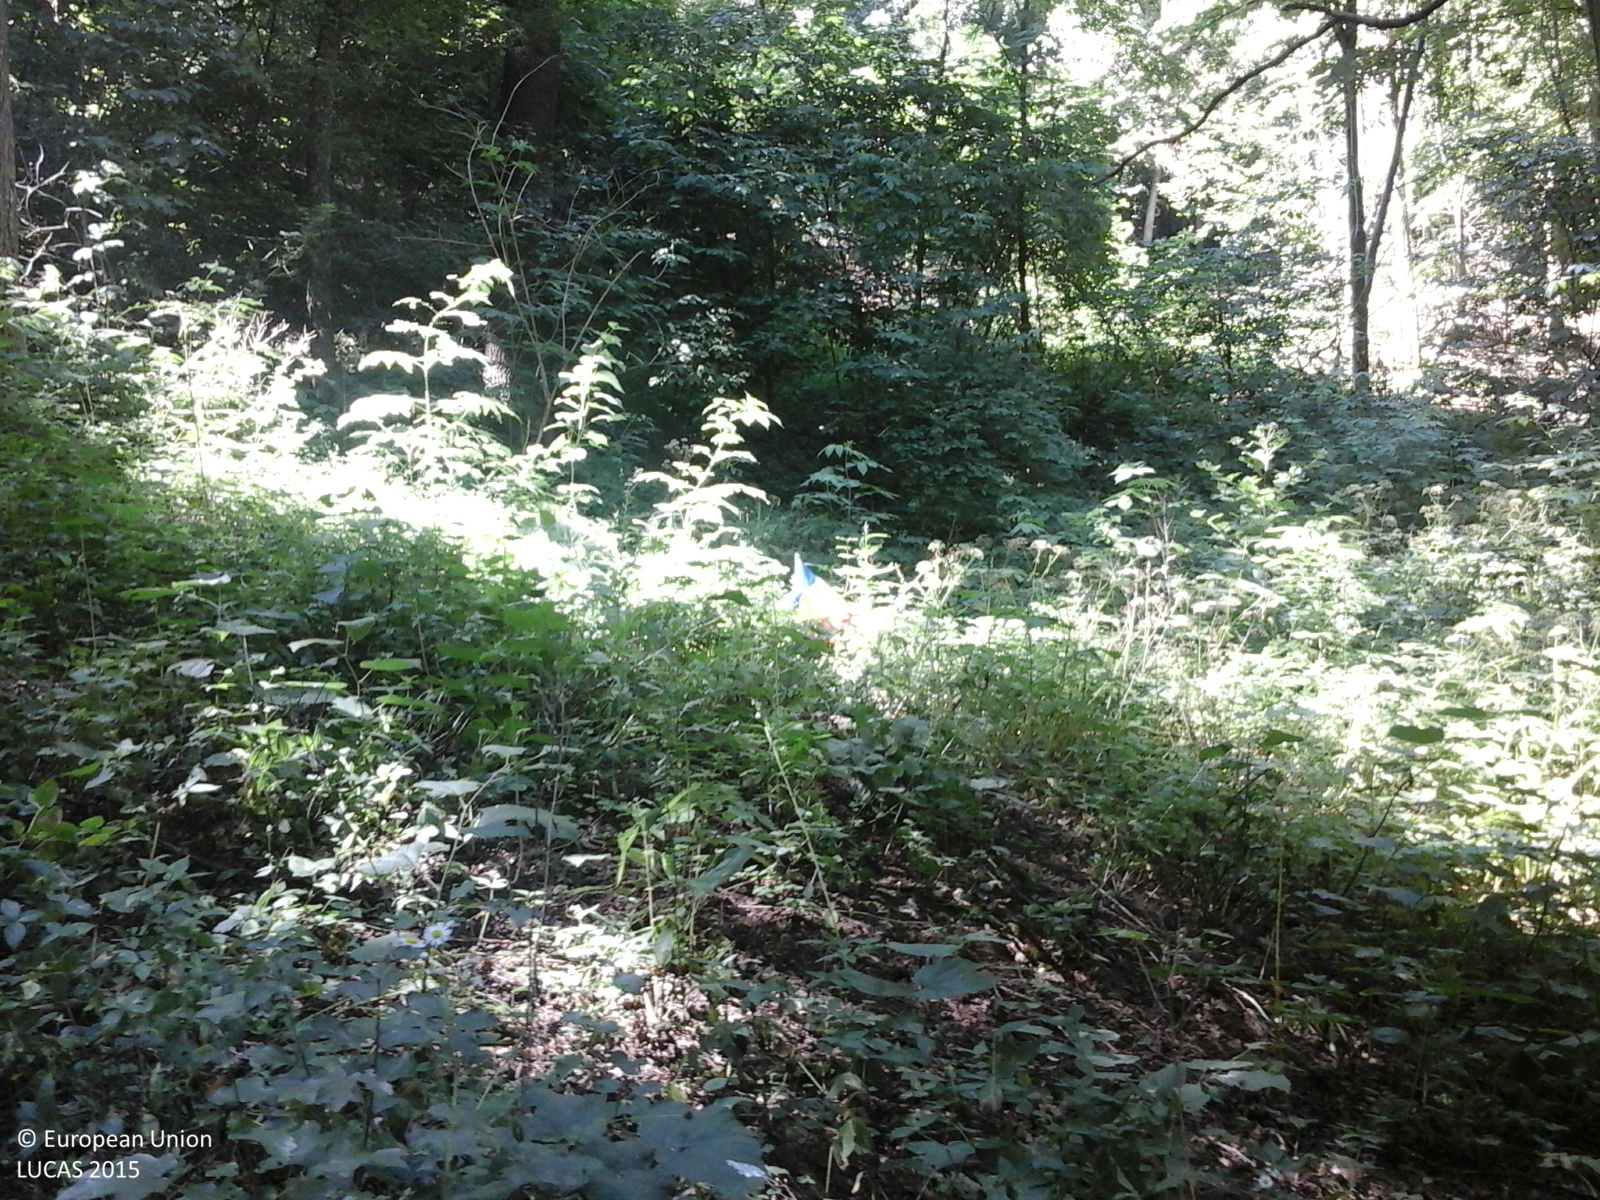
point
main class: Woodland
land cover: Broadleaved woodland
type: beech forest
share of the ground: > 75 %
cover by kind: broadleaved forest trees 80 %, herbaceous plants 15 %, shrubs 5 %
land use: Forestry
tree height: > 5 m
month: July
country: RO
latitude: 44.5889
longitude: 24.3659
